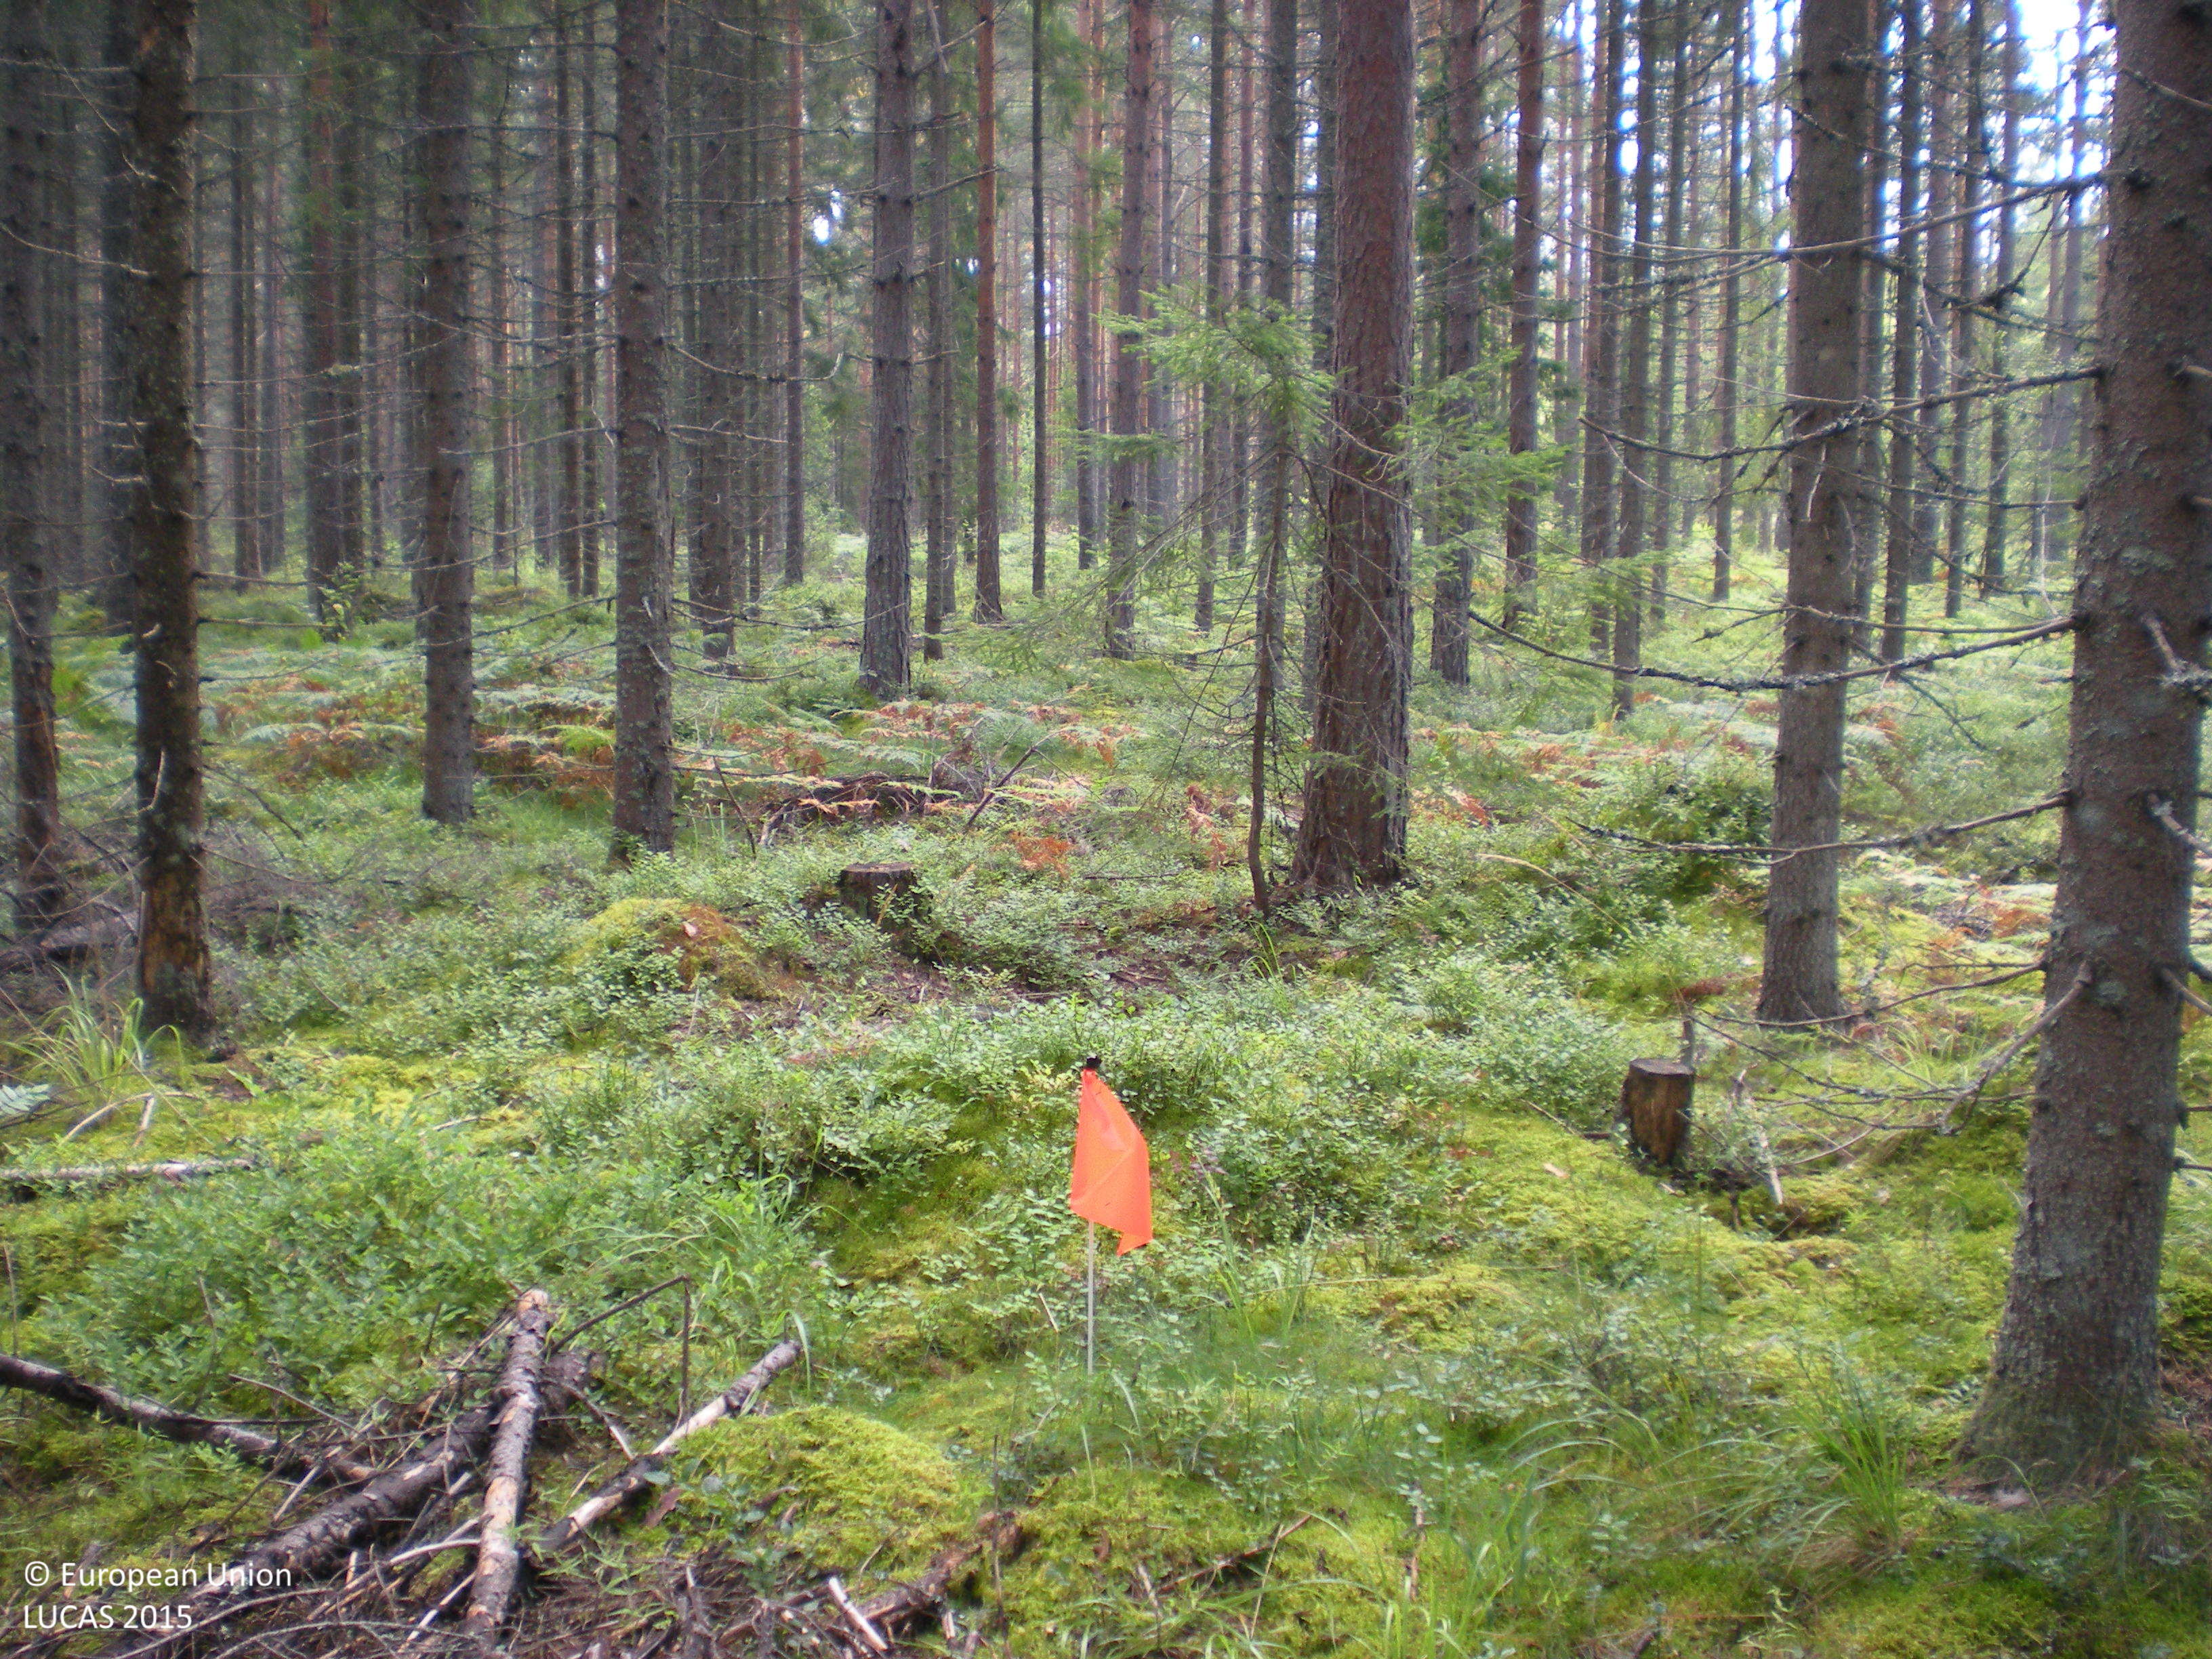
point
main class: Woodland
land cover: Other coniferous woodland
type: boreal forest
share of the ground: > 75 %
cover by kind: coniferous forest trees 75 %, shrubs 15 %, herbaceous plants 5 %, lichens and mosses 5 %
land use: Forestry
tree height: > 5 m
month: August
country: SE
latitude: 60.4898
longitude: 17.1059
